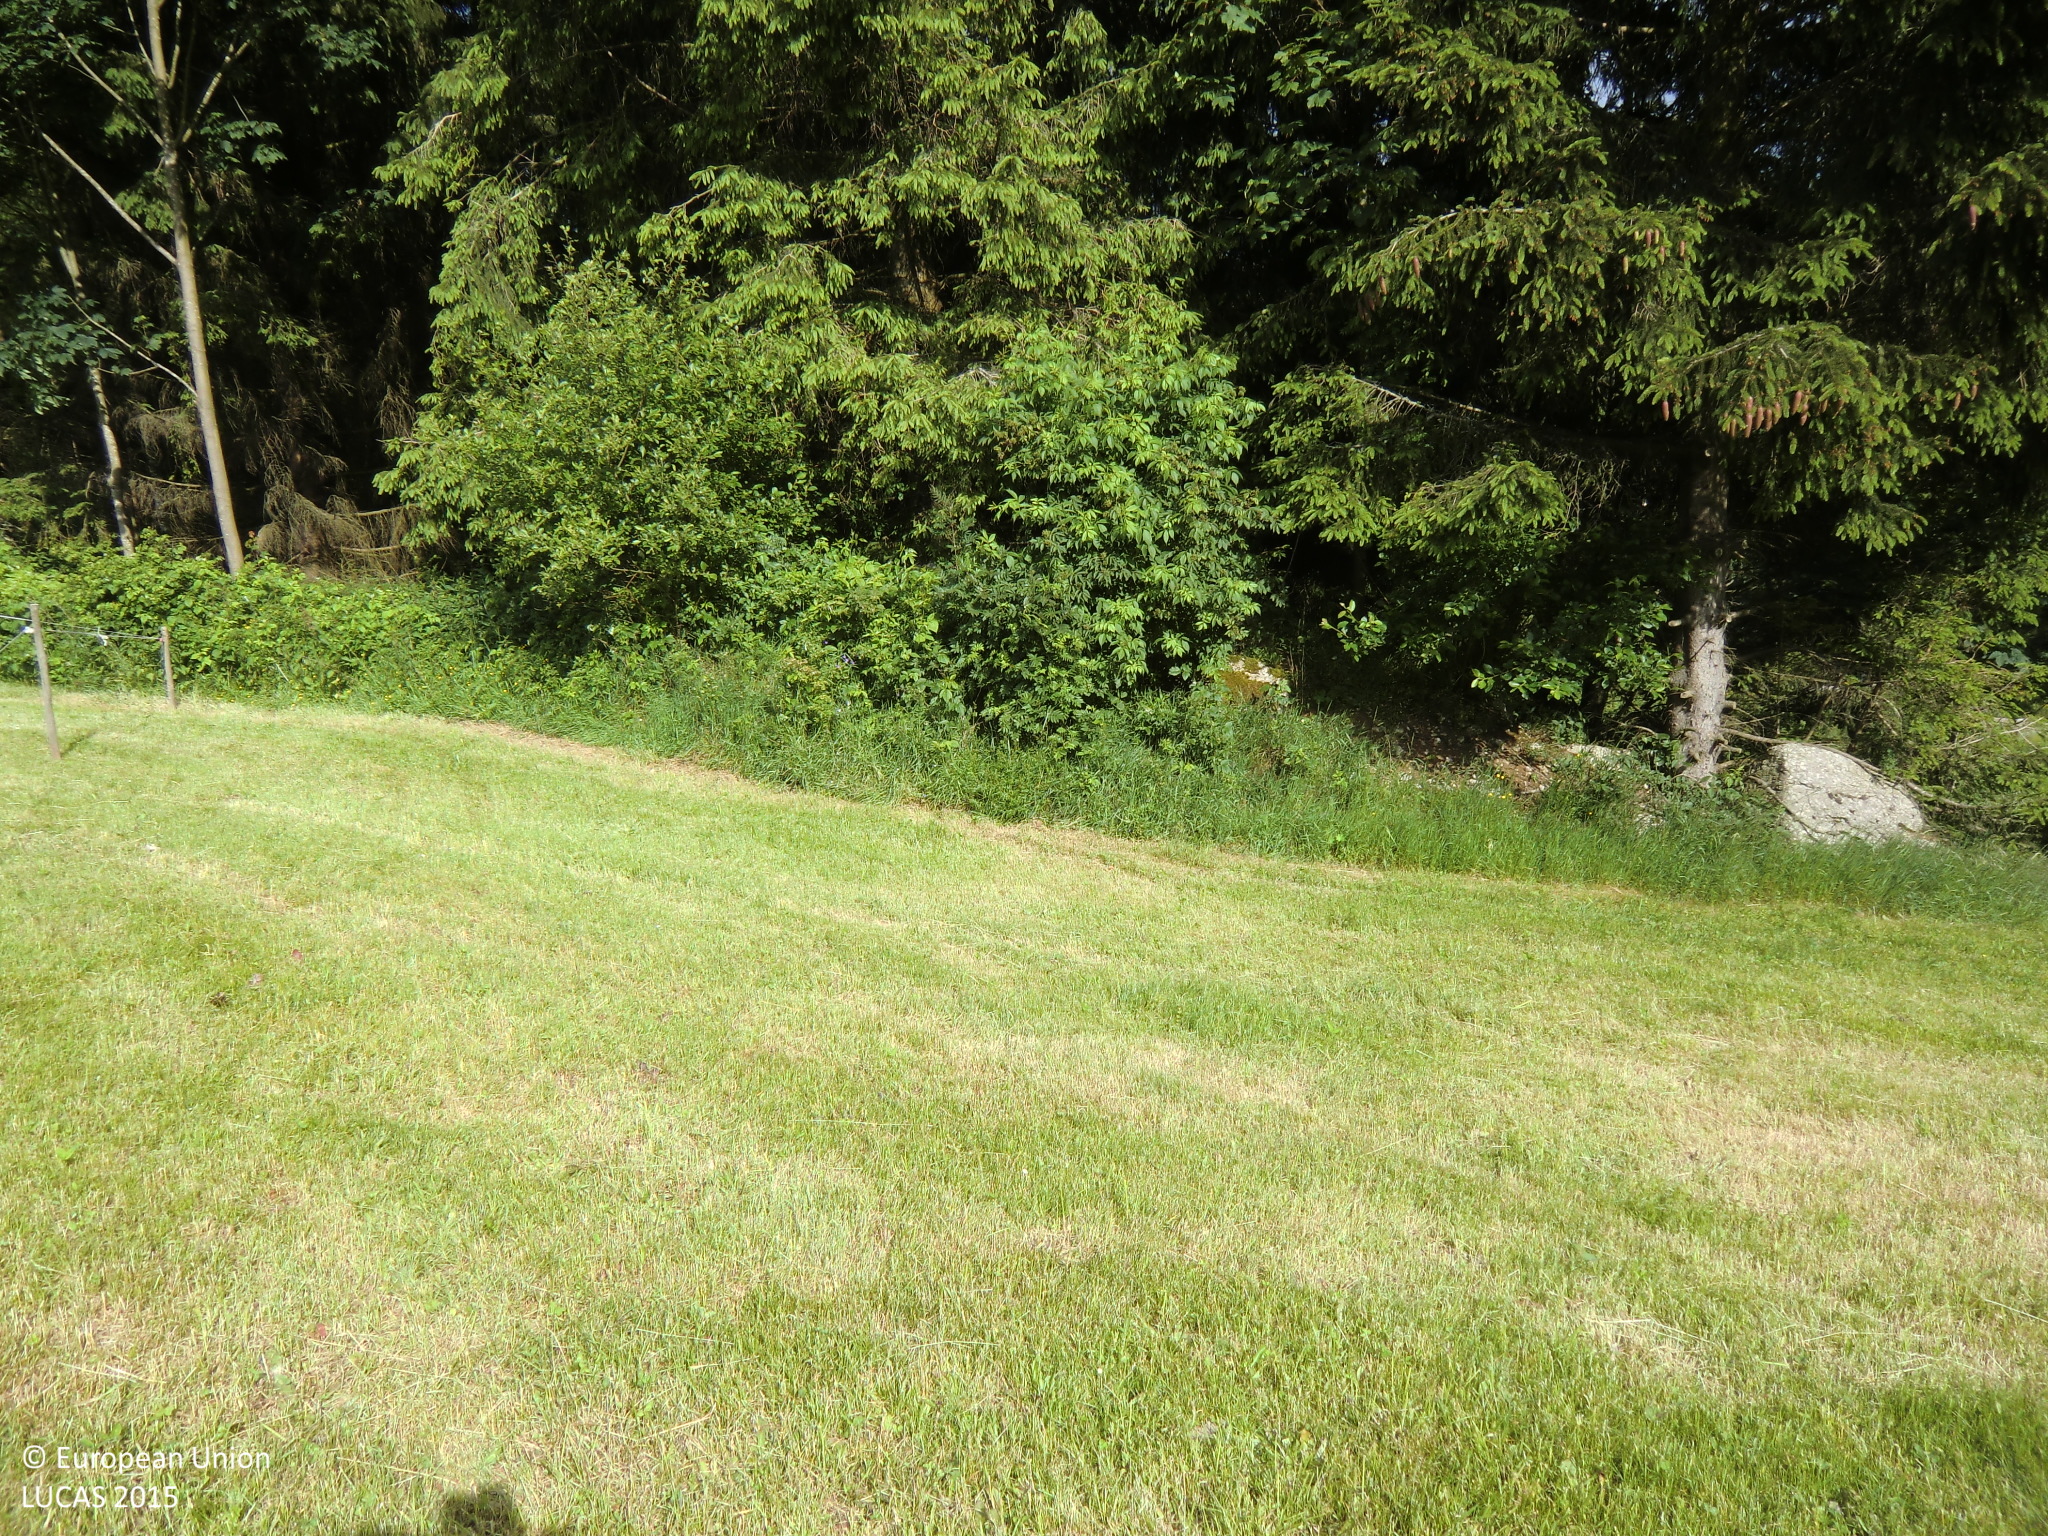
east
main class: Grassland
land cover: Grassland without tree/shrub cover
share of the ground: > 75 %
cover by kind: herbaceous plants 100 %
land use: Agriculture (excluding fallow land and kitchen gardens)
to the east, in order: Grassland without tree/shrub cover; Fences; Spruce dominated mixed woodland; Spruce dominated coniferous woodland; Tracks; Spruce dominated coniferous woodland; Rivers and streams; Spruce dominated coniferous woodland; Ditches and canals; Grassland with sparse tree/shrub cover; Ditches and canals; Spruce dominated coniferous woodland
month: June
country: AT
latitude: 48.5141
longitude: 14.8342
